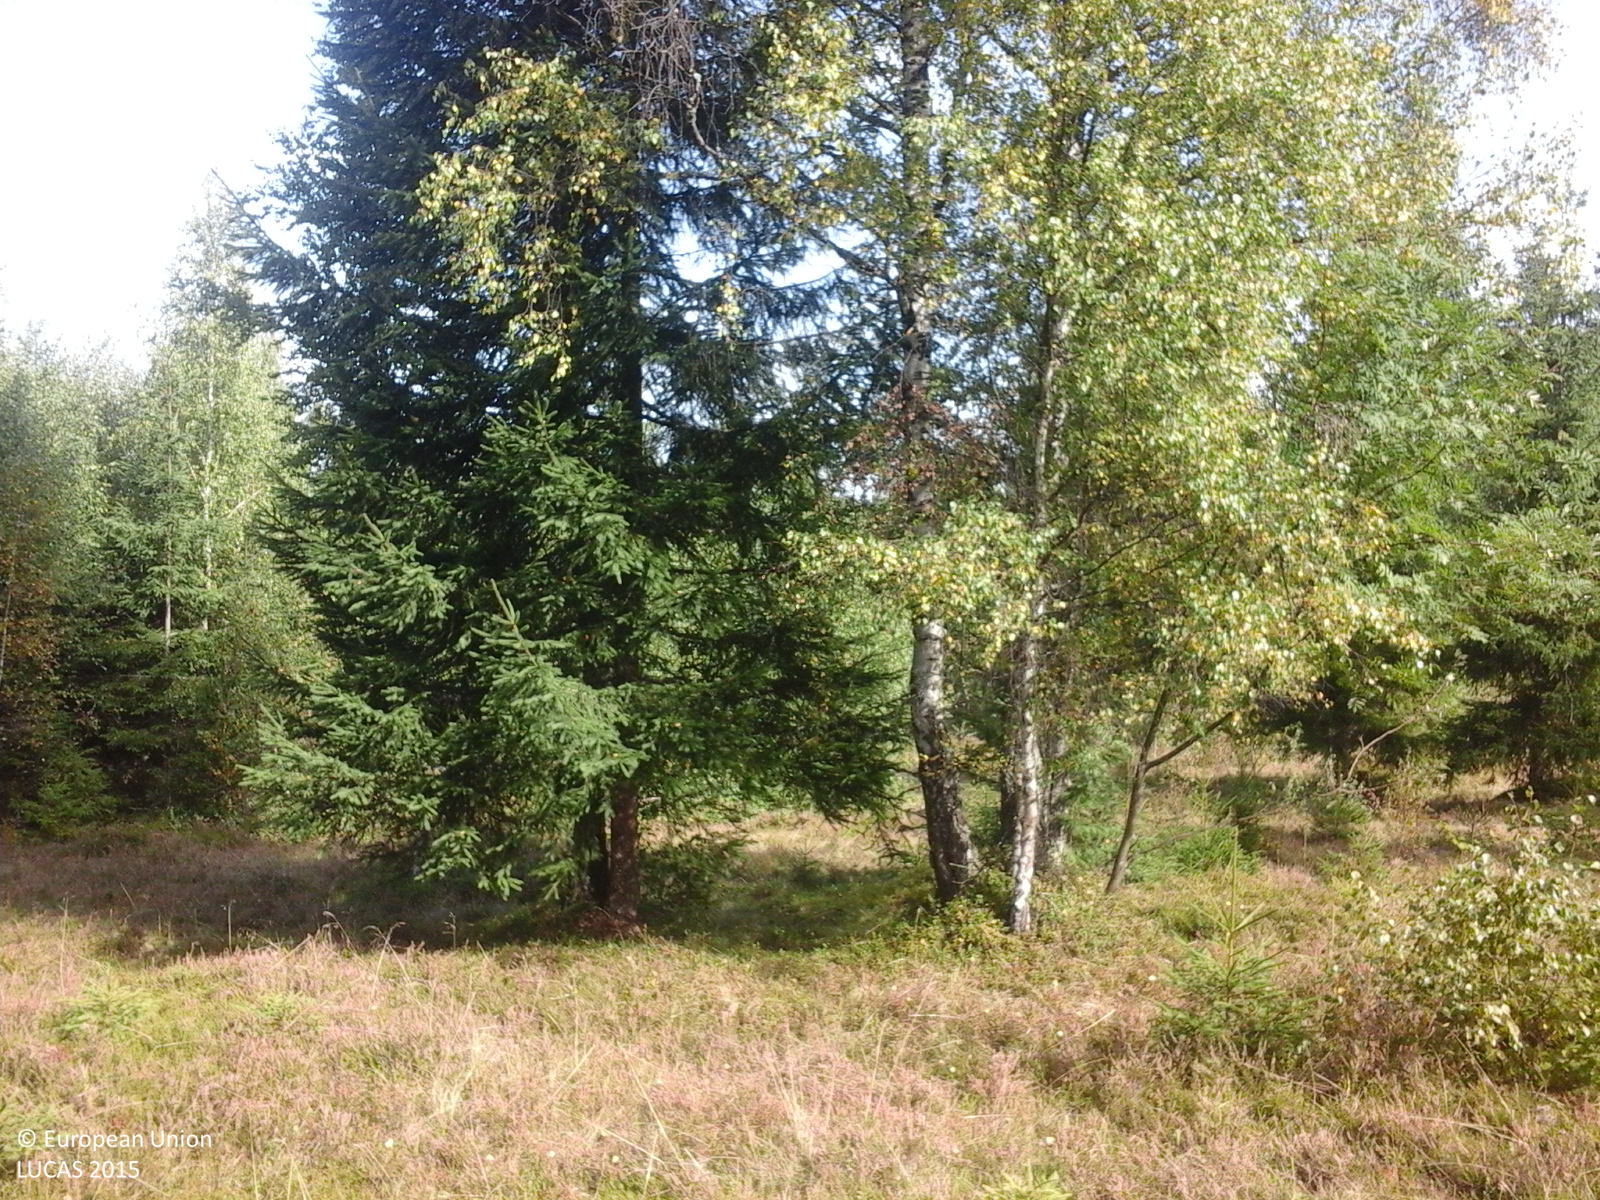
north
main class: Woodland
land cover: Spruce dominated mixed woodland
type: alpine coniferous forest
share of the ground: > 75 %
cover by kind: coniferous forest trees 50 %, broadleaved forest trees 30 %, herbaceous plants 15 %, shrubs 5 %
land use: Forestry
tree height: > 5 m
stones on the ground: < 10 %
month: September
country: RO
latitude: 46.7144
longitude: 23.0515
